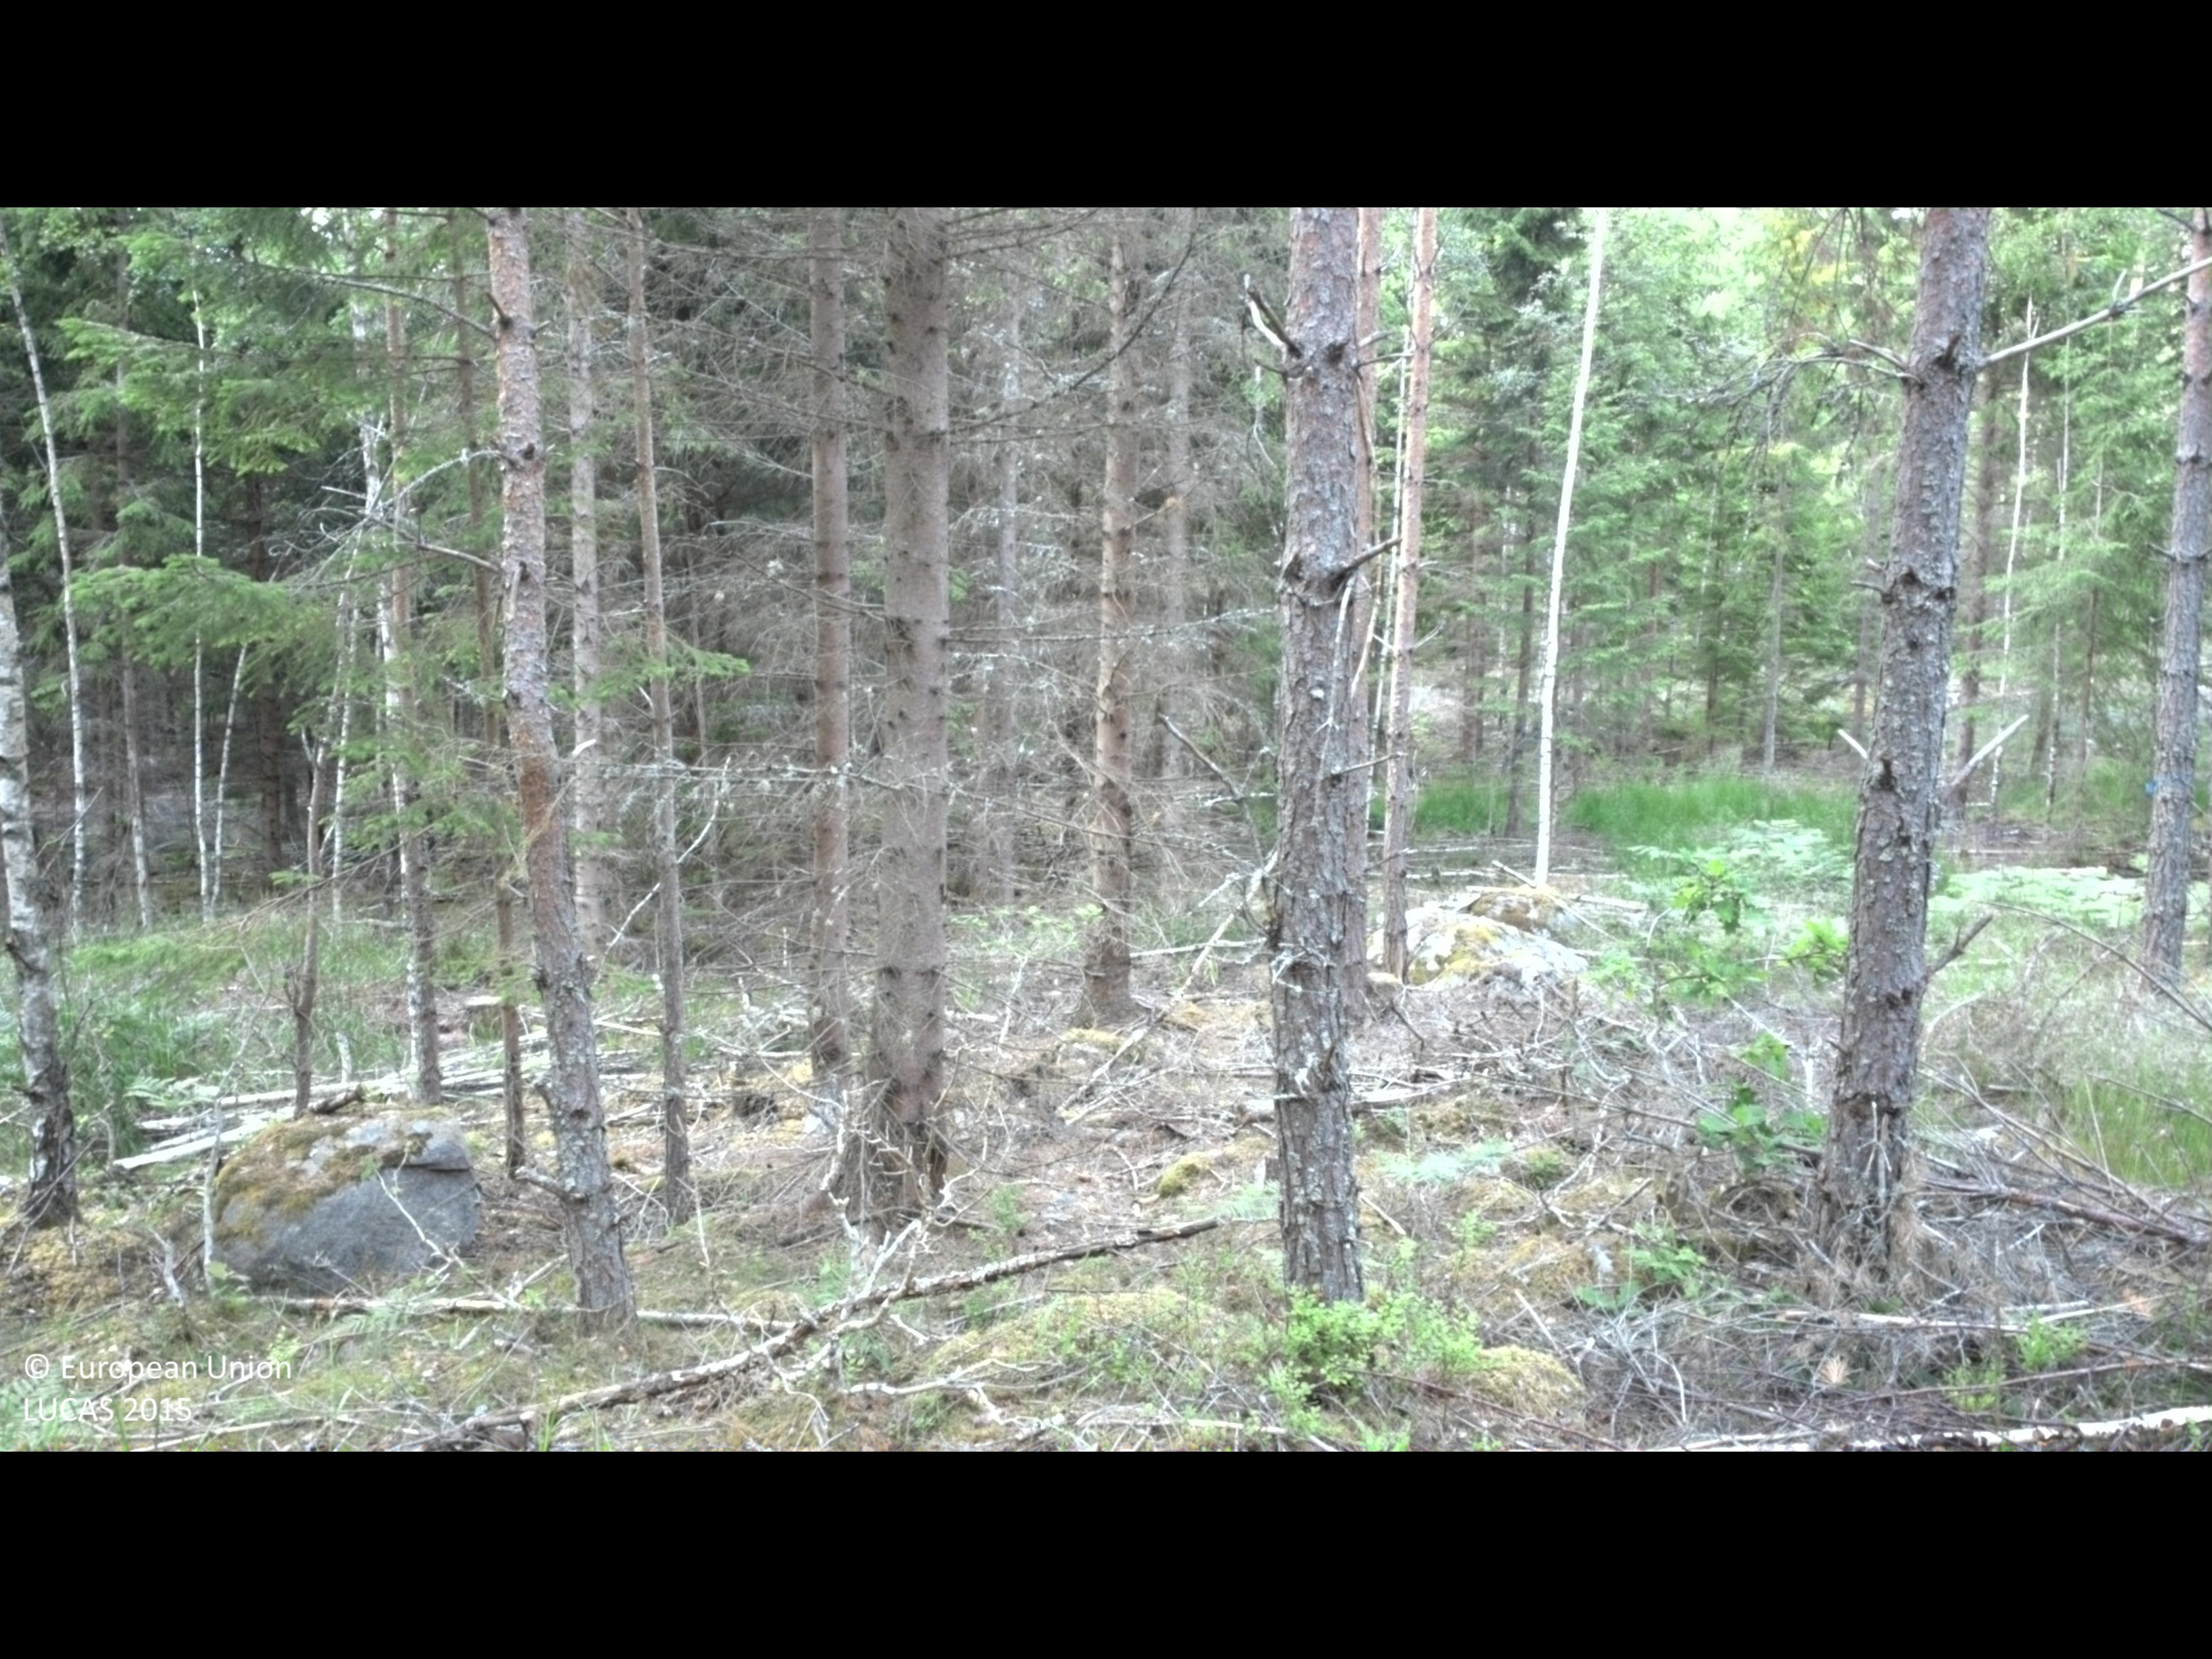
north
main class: Woodland
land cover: Pine dominated mixed woodland
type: boreal forest
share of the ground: 50 - 75 %
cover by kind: coniferous forest trees 45 %, broadleaved forest trees 20 %, herbaceous plants 15 %, shrubs 10 %, lichens and mosses 10 %
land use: Forestry
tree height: > 5 m
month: June
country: SE
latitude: 58.2562
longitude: 16.2162
